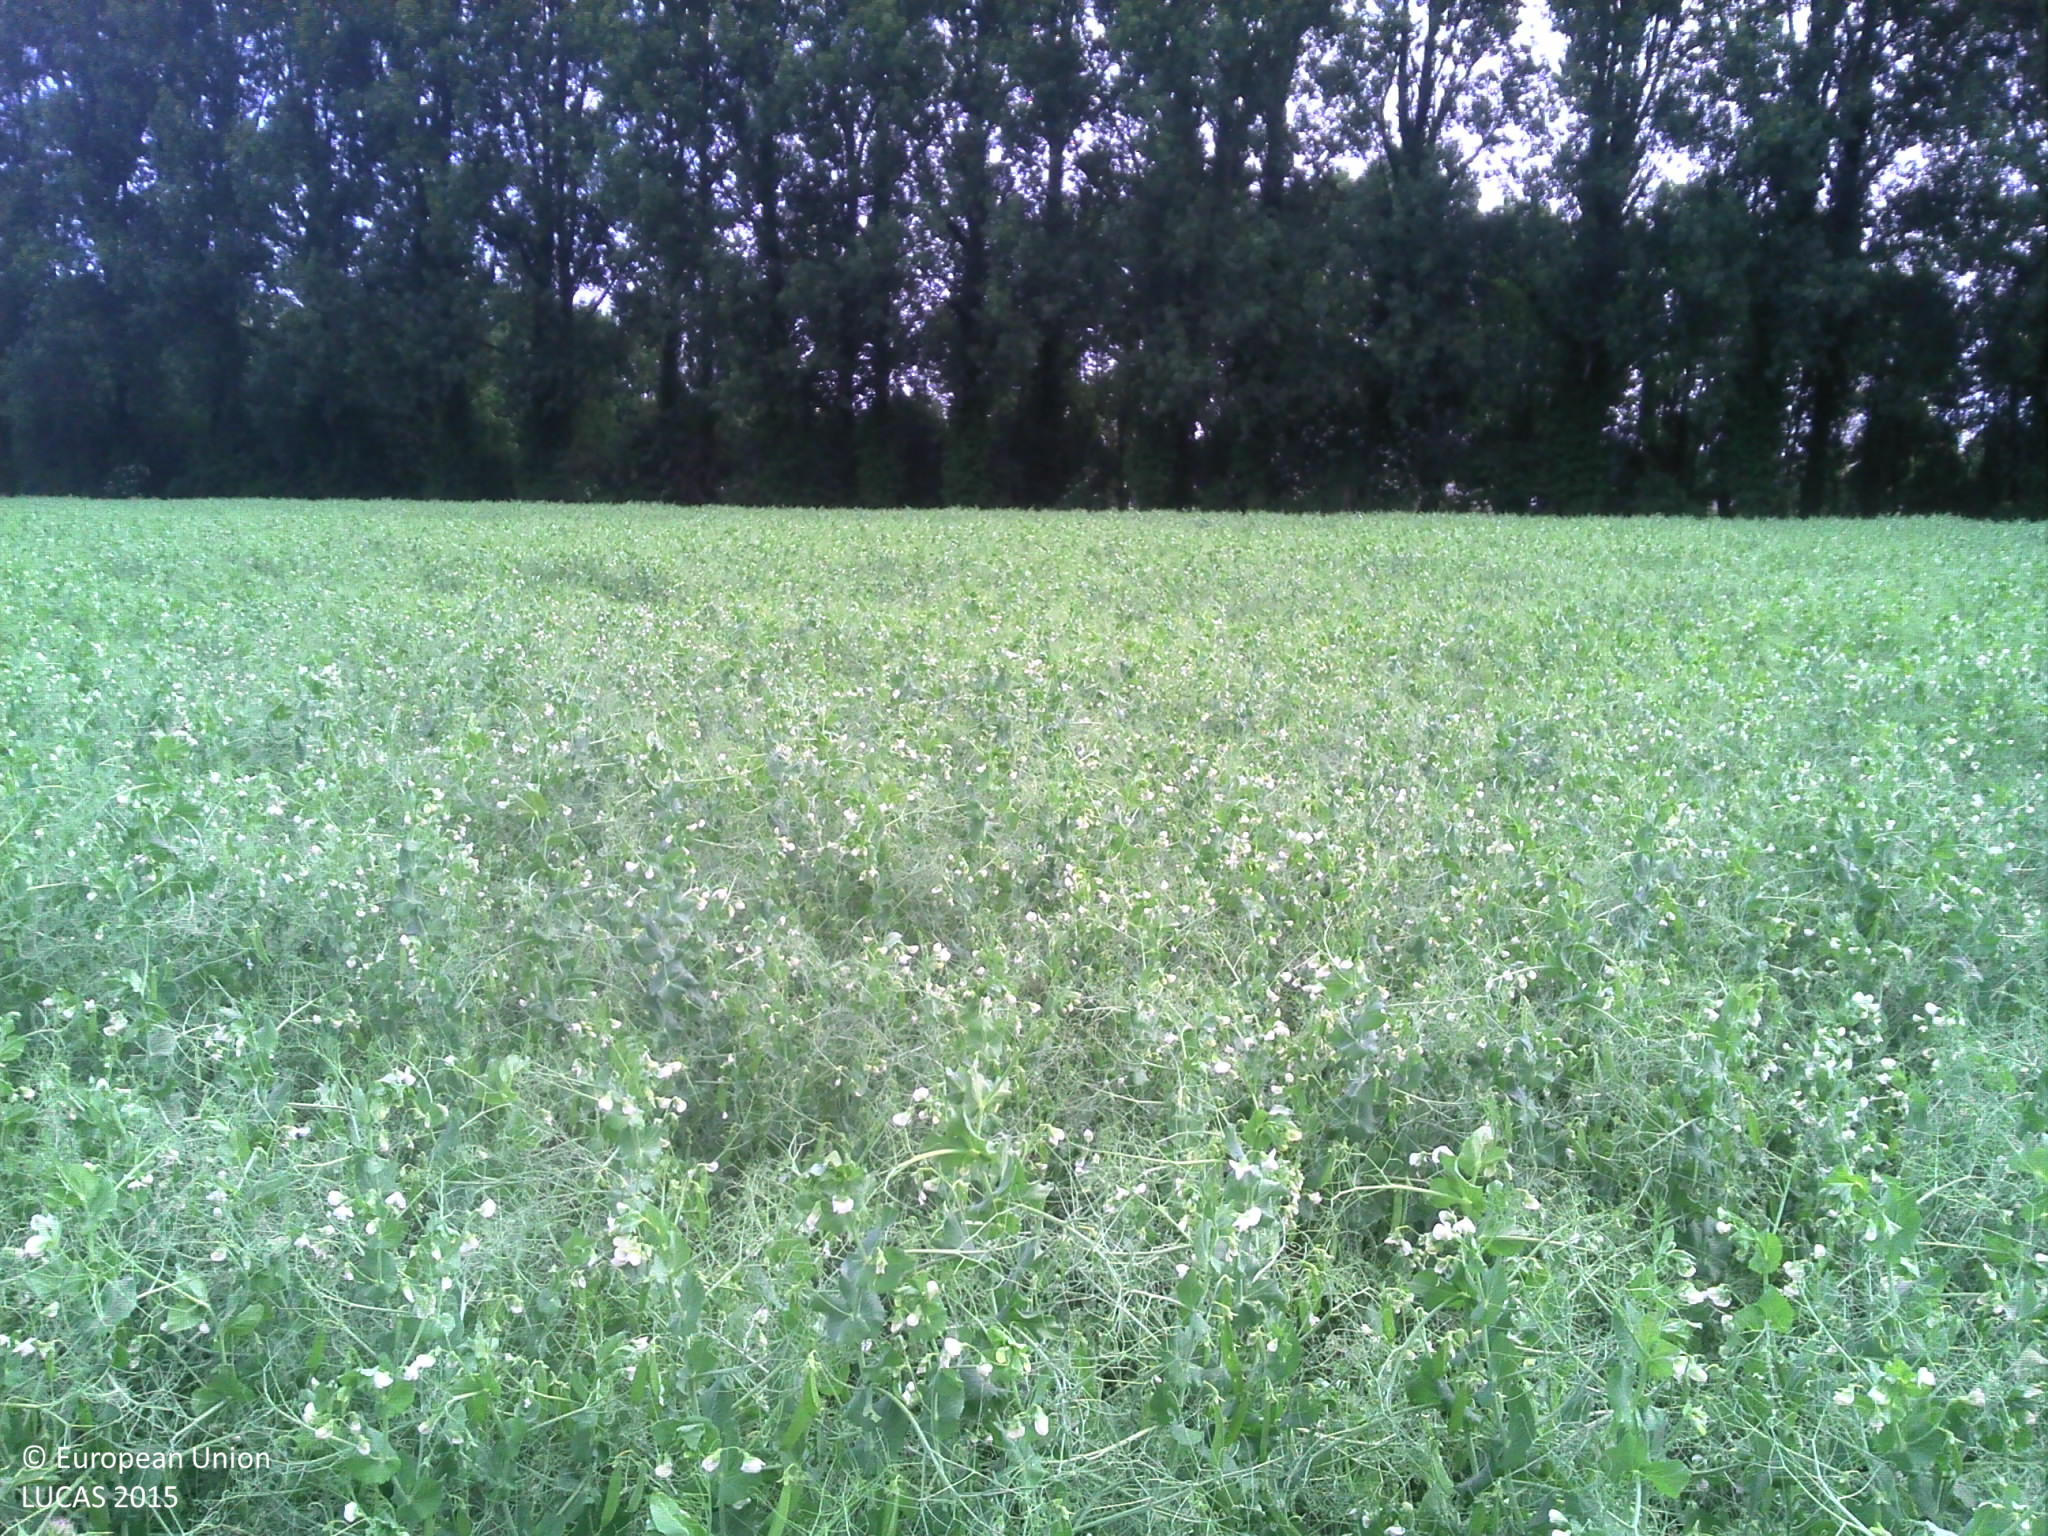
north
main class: Grassland
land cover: Grassland with sparse tree/shrub cover
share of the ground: > 75 %
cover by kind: herbaceous plants 95 %, broadleaved forest trees 5 %
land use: Agriculture (excluding fallow land and kitchen gardens)
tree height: > 5 m
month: June
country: FR
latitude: 49.7655
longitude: 2.3650
